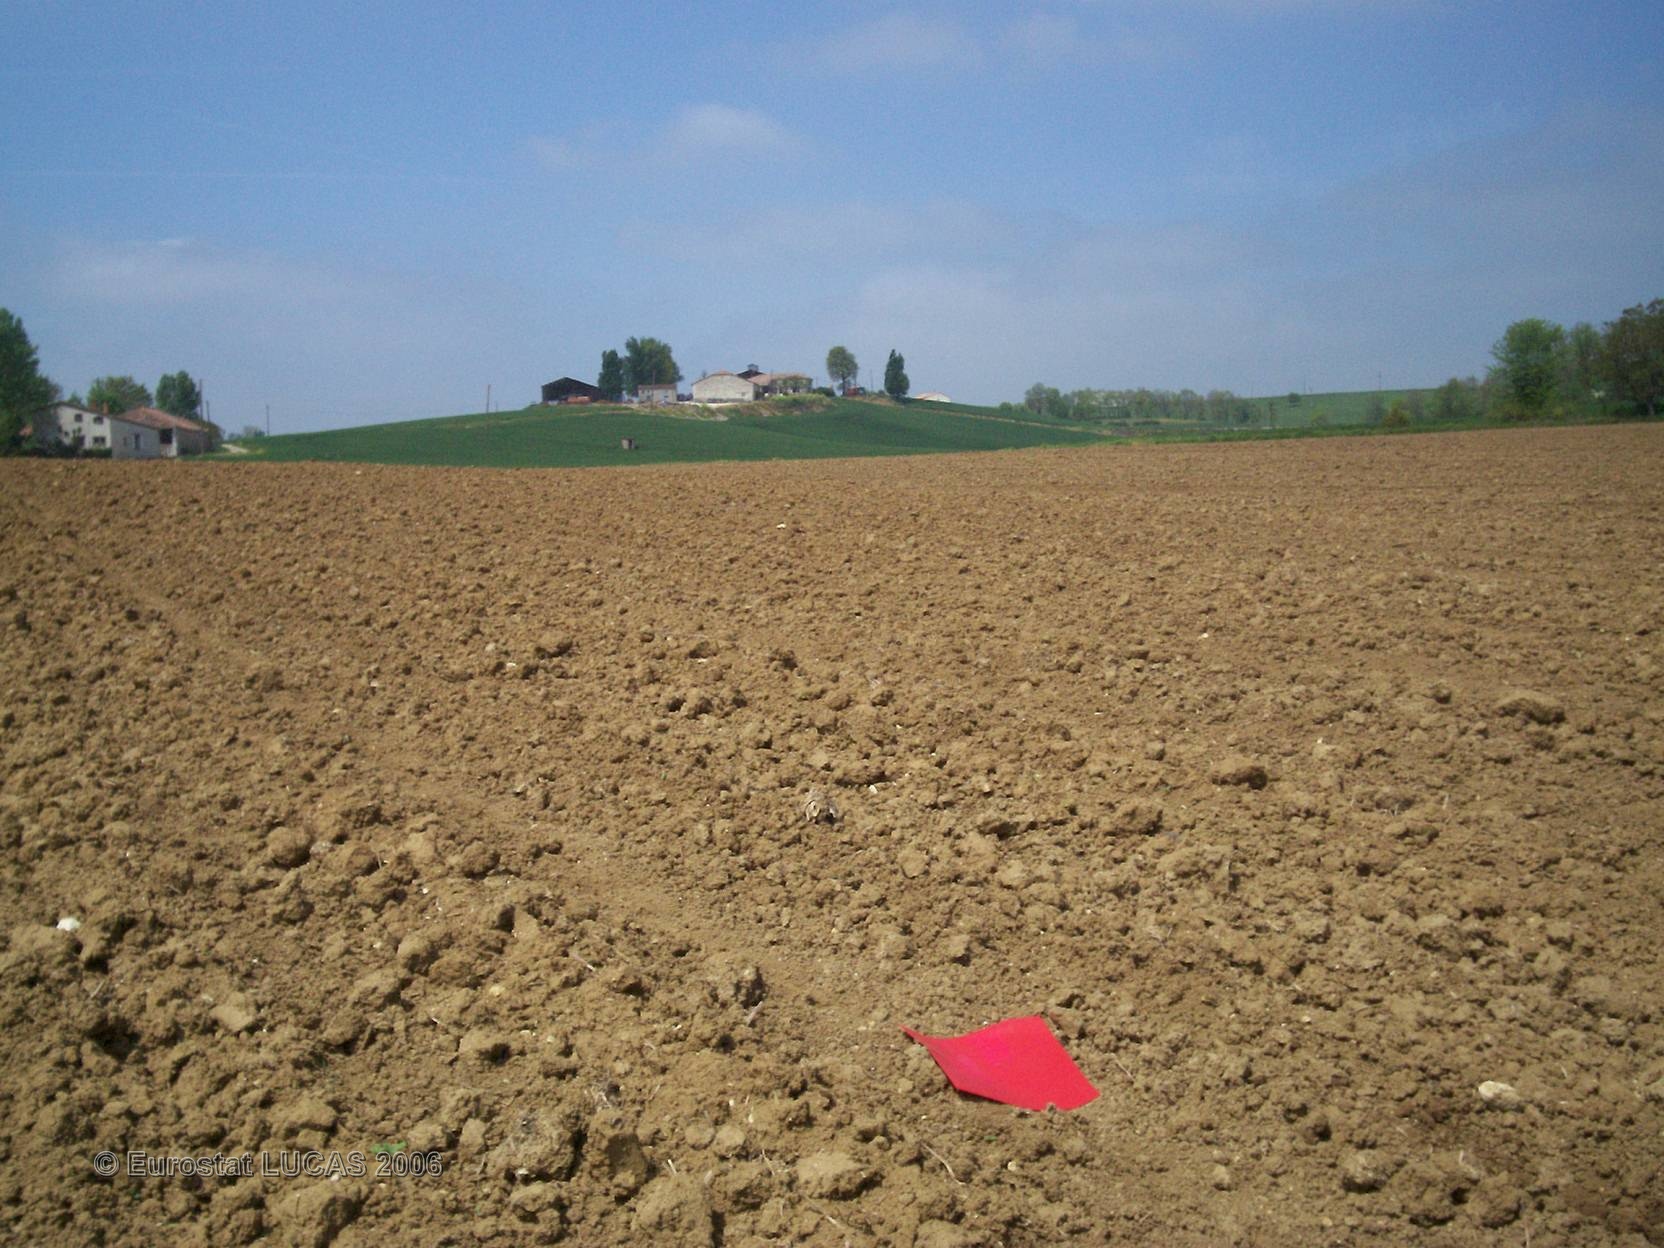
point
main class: Cropland
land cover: Sunflower
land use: Agriculture (excluding fallow land and kitchen gardens)
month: April
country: FR
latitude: 44.2465
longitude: 0.7660
